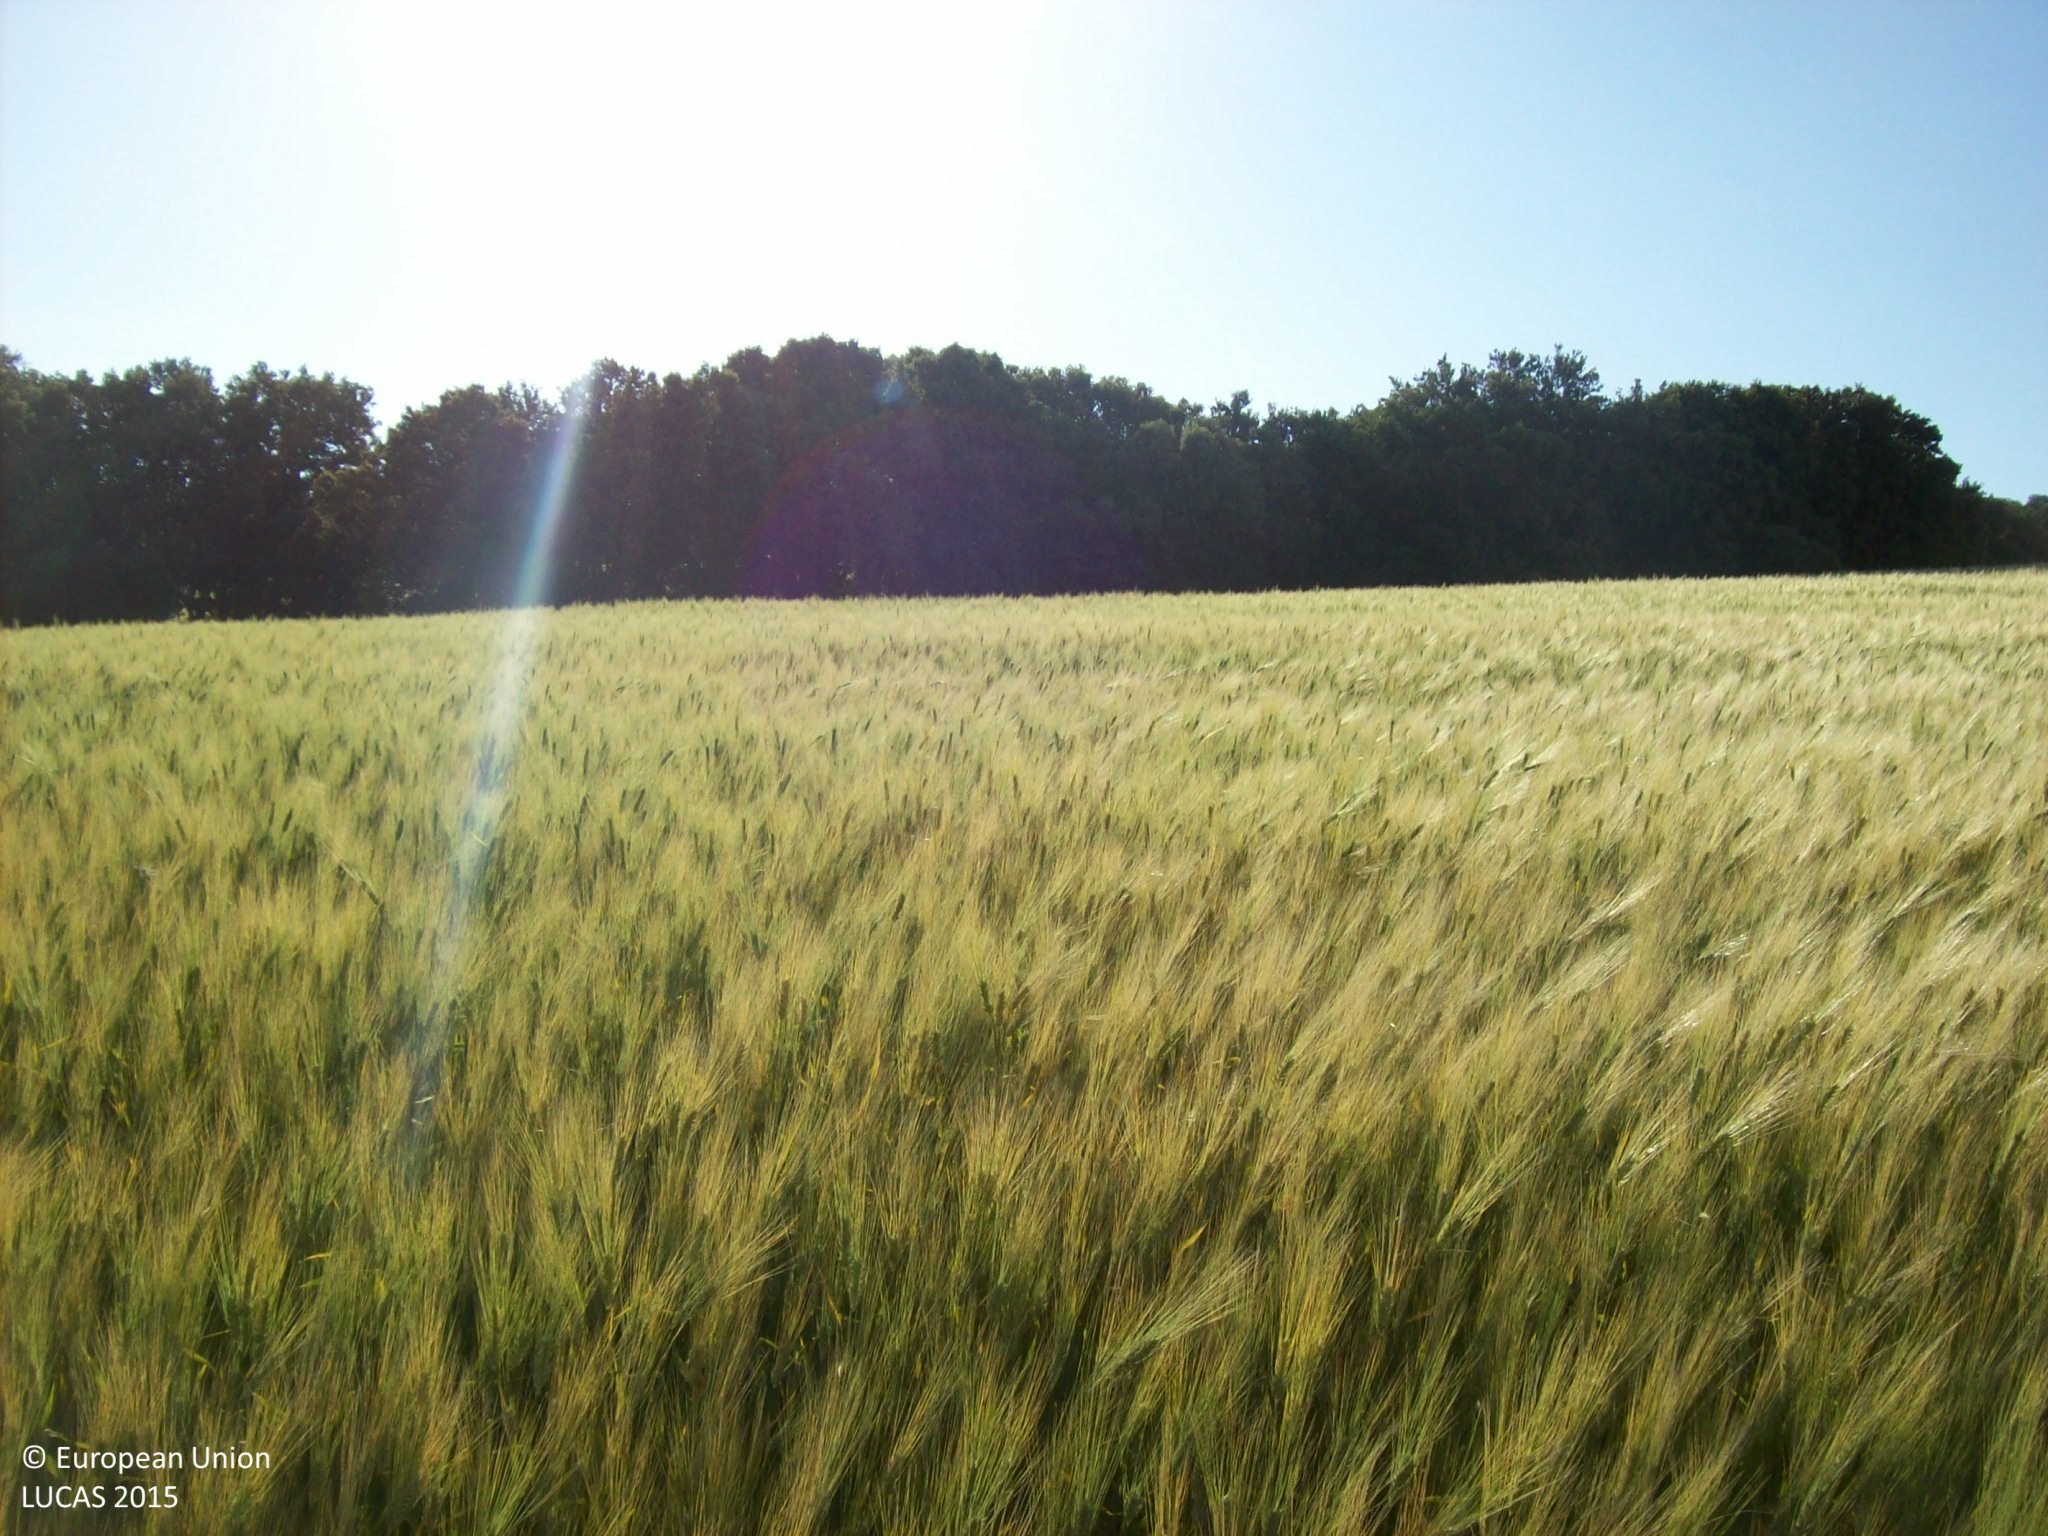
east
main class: Cropland
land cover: Barley
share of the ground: > 75 %
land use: Agriculture (excluding fallow land and kitchen gardens)
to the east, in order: Barley; Broadleaved woodland; Barley; Broadleaved woodland
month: May
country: ES
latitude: 40.9216
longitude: -4.5313
